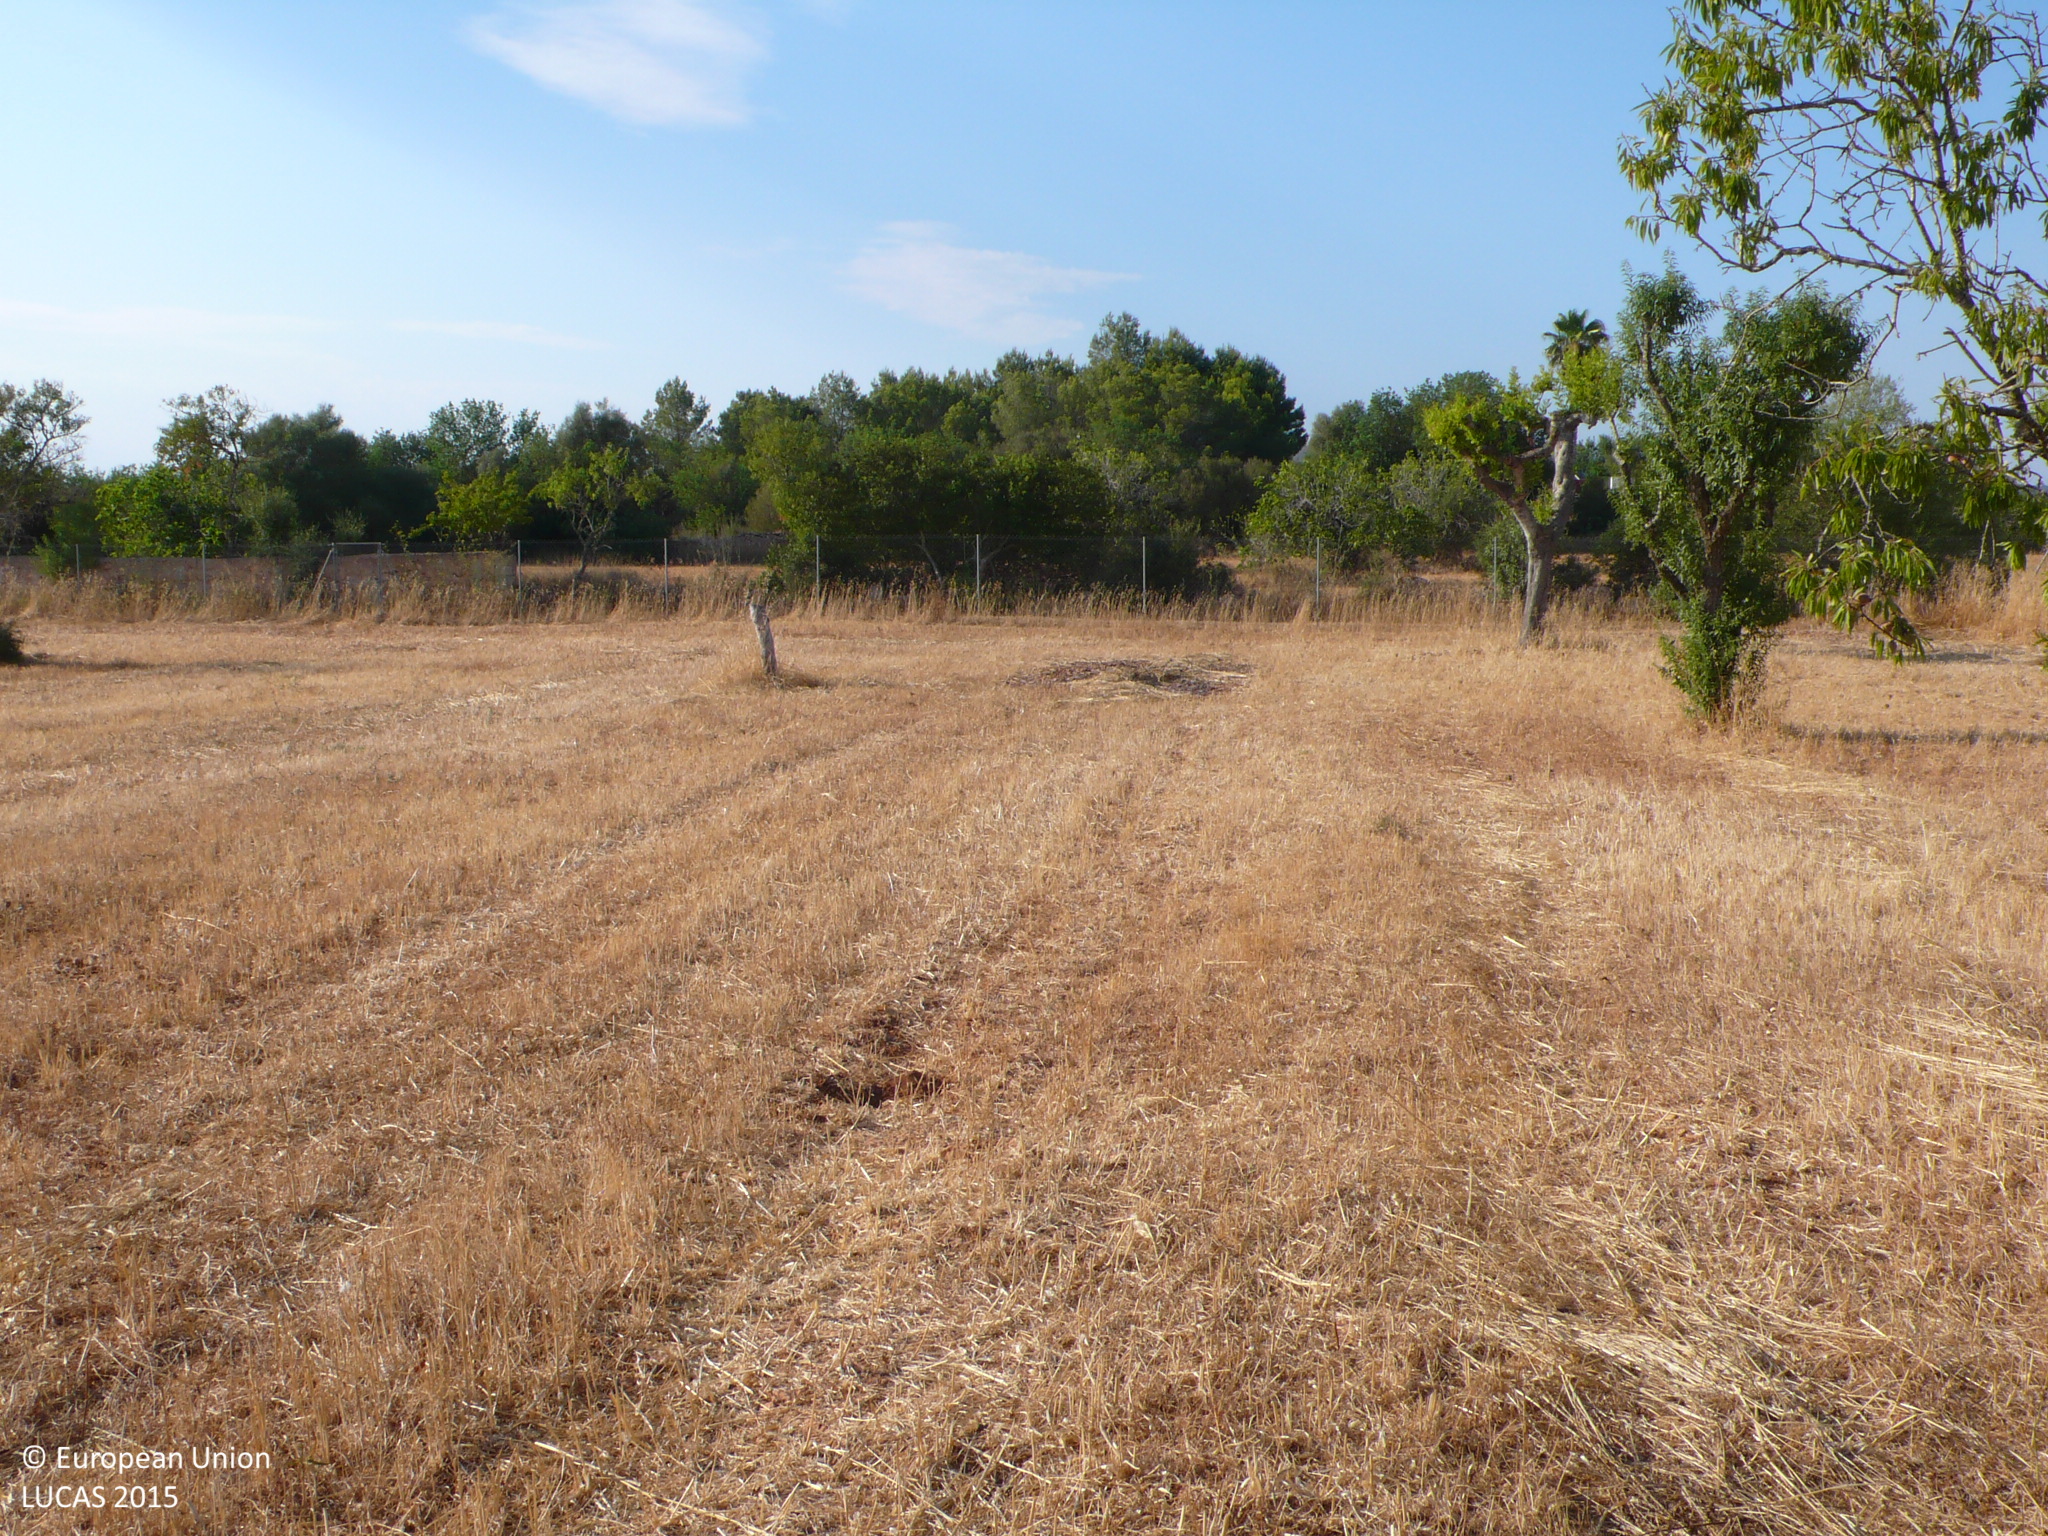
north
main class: Cropland
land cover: Permanent industrial crops
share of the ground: 10 - 25 %
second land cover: Spontaneously vegetated surfaces
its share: > 75 %
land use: Agriculture (excluding fallow land and kitchen gardens)
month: July
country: ES
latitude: 39.4636
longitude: 2.8830
